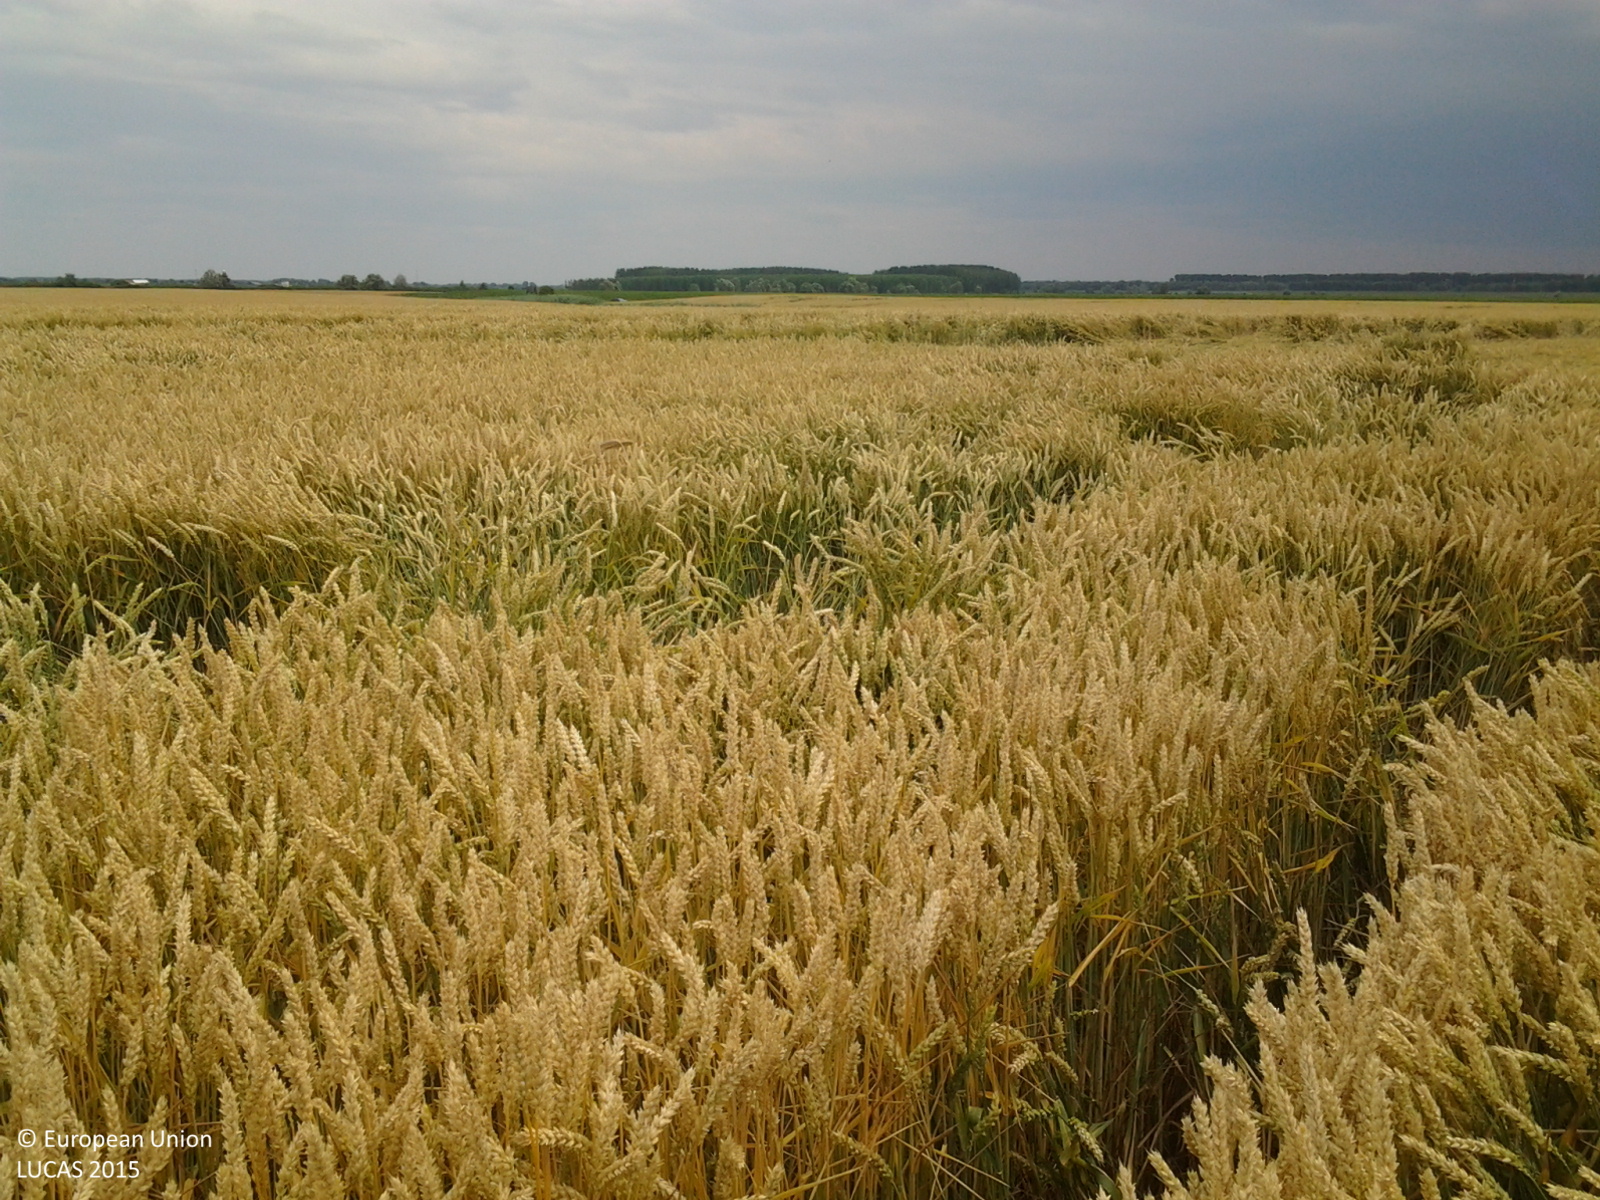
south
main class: Cropland
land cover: Common wheat
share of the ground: > 75 %
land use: Agriculture (excluding fallow land and kitchen gardens)
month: June
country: HU
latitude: 46.7602
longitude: 21.2037
